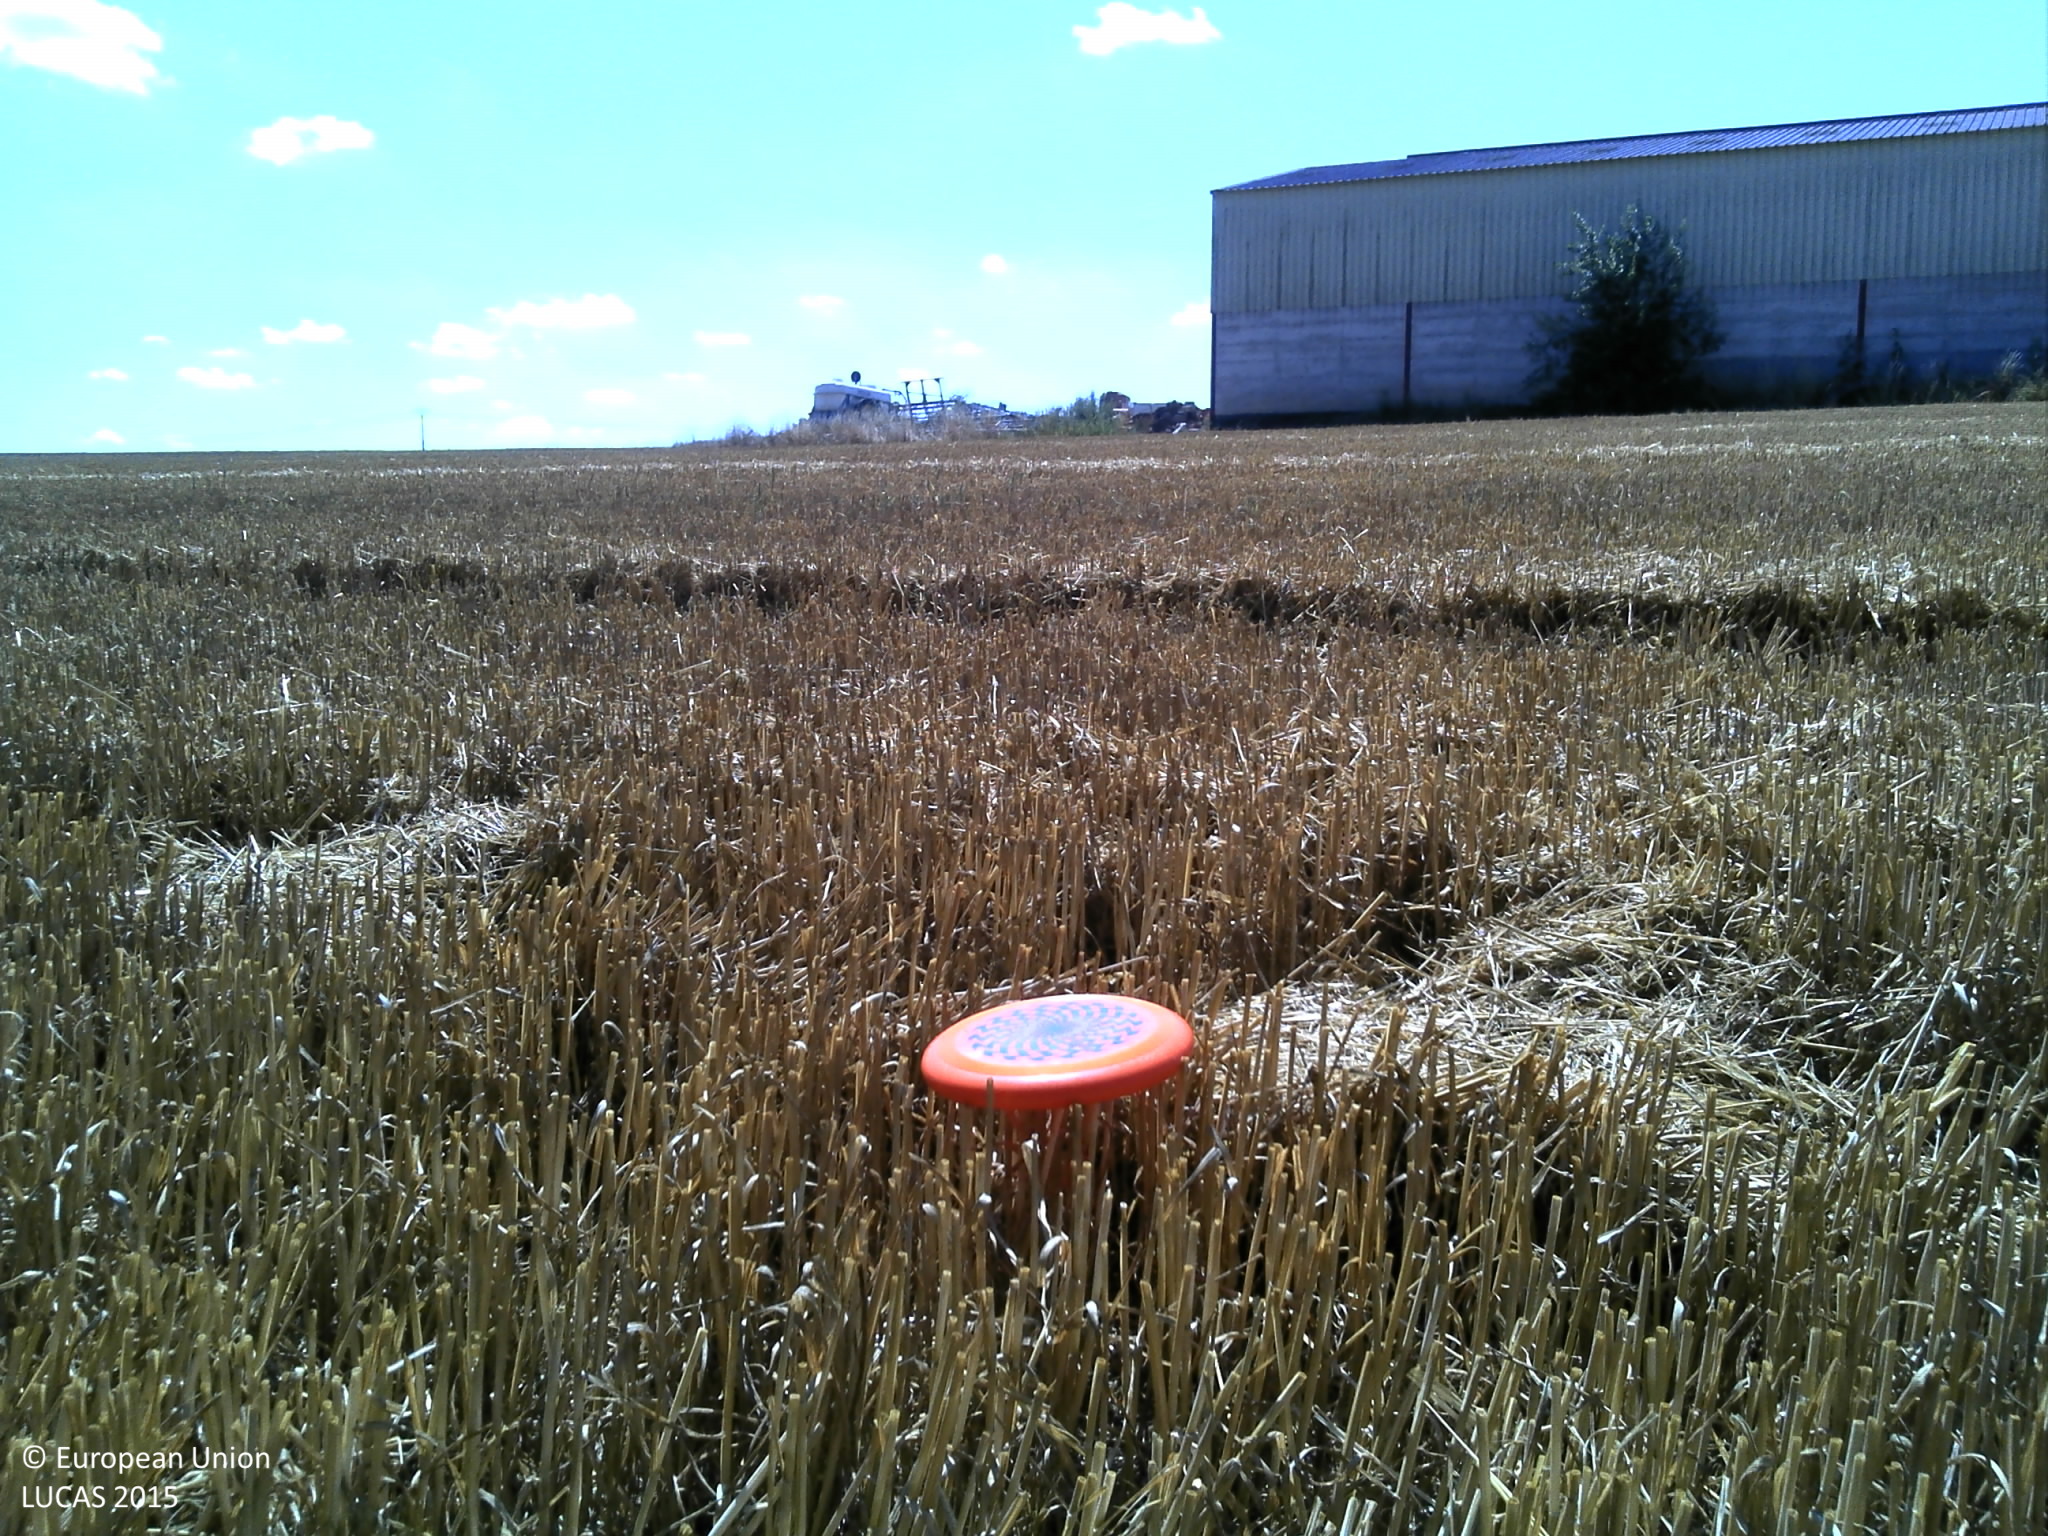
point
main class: Cropland
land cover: Common wheat
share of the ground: > 75 %
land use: Agriculture (excluding fallow land and kitchen gardens)
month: August
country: FR
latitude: 49.0338
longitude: 4.7037
